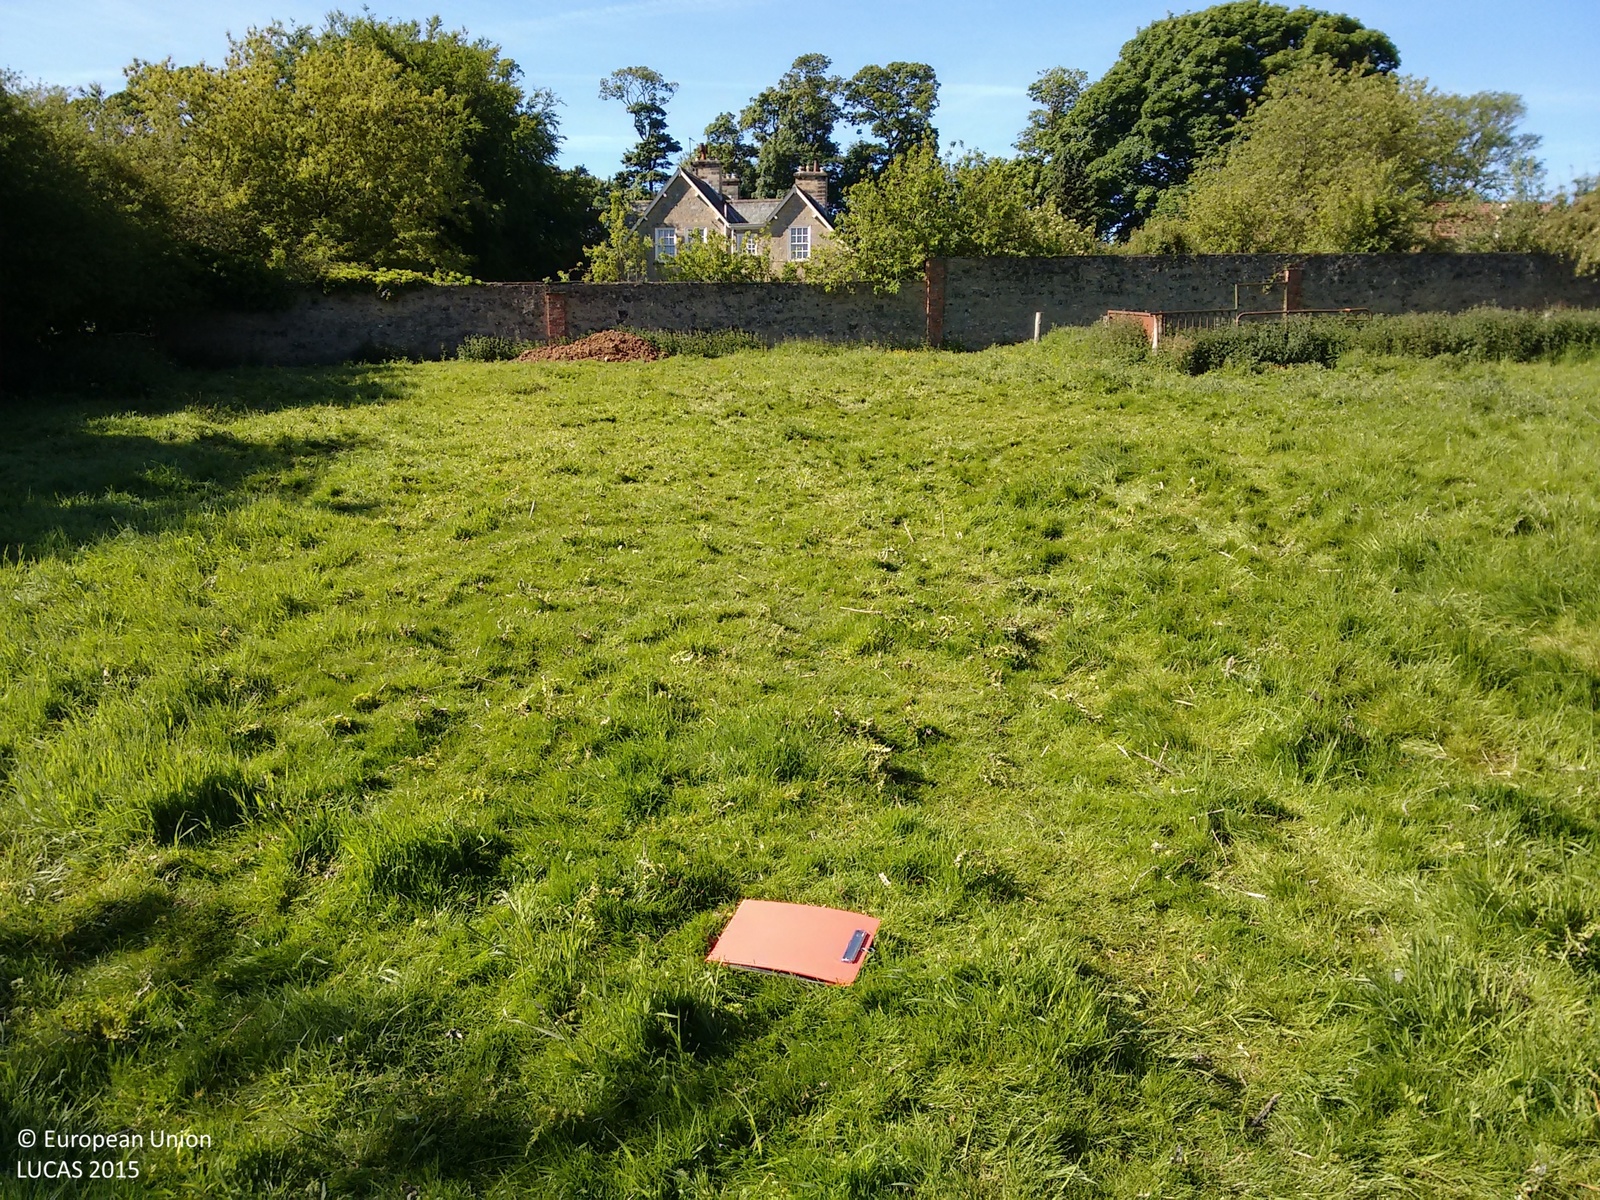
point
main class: Grassland
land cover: Grassland without tree/shrub cover
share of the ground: > 75 %
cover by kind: herbaceous plants 100 %
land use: Agriculture (excluding fallow land and kitchen gardens)
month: June
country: GB
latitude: 54.1893
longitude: -1.1862
